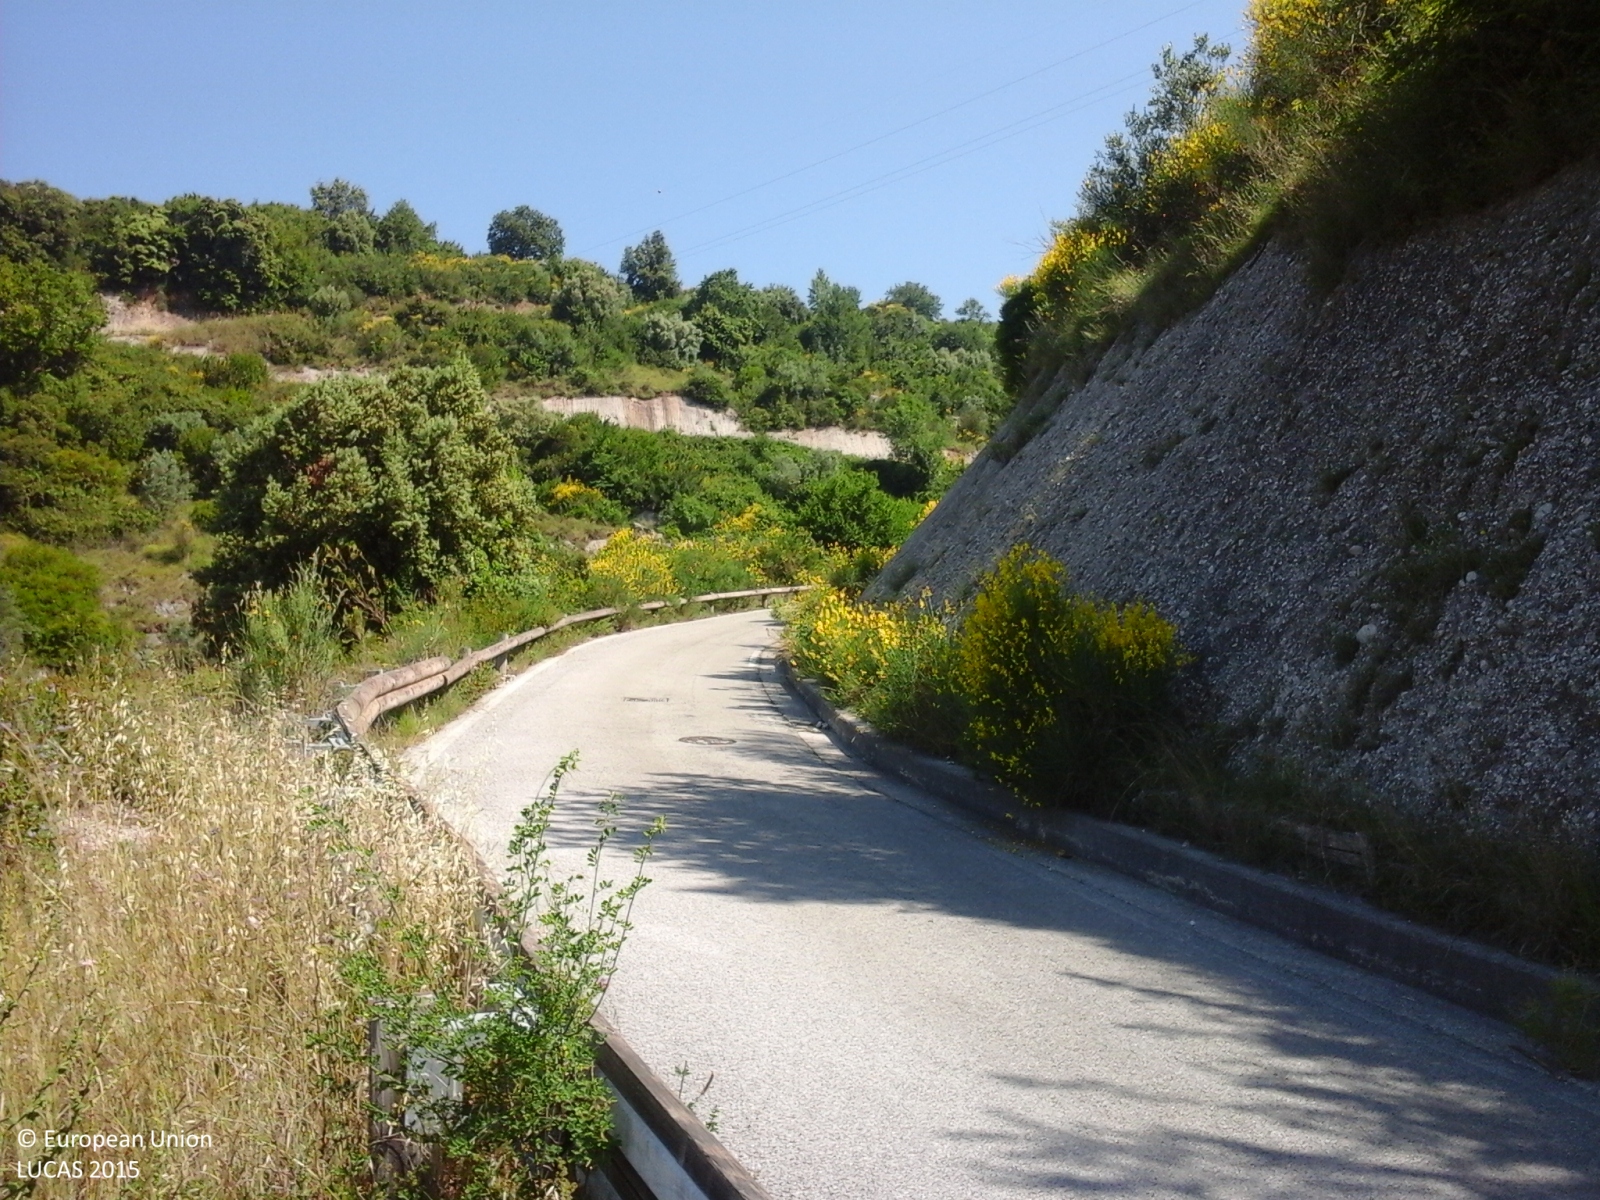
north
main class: Cropland
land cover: Olive groves
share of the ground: 50 - 75 %
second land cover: Grassland without tree/shrub cover
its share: 50 - 75 %
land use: Abandoned areas
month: June
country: IT
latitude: 40.6267
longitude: 15.0508
